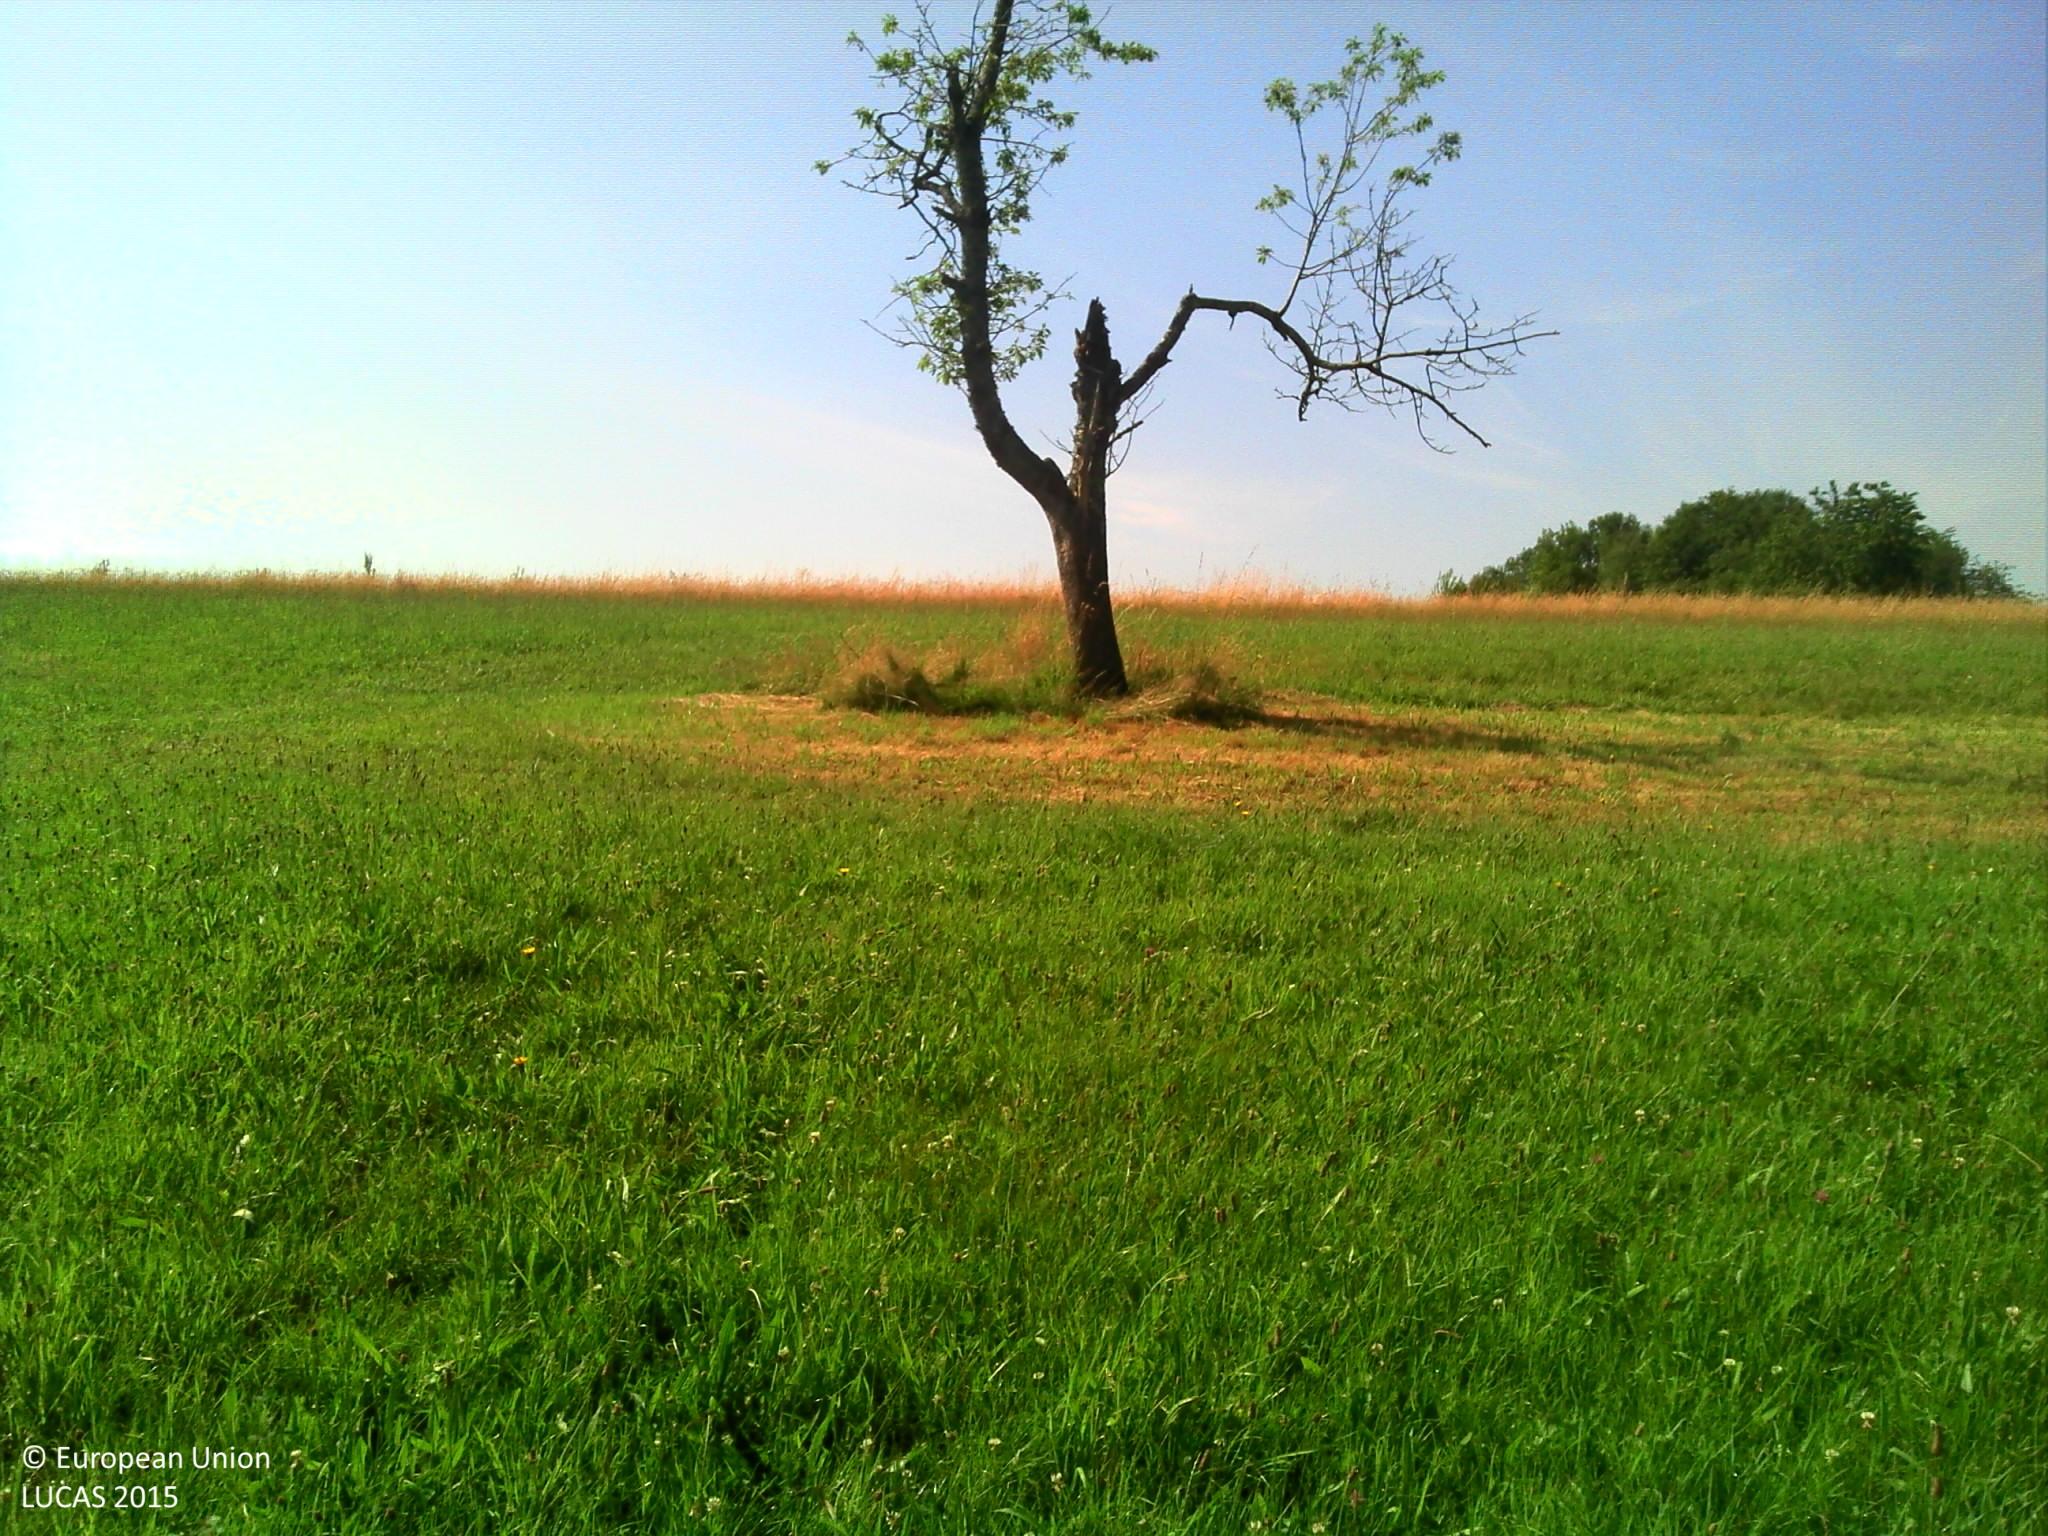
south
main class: Grassland
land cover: Grassland without tree/shrub cover
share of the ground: > 75 %
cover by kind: herbaceous plants 100 %
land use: Agriculture (excluding fallow land and kitchen gardens)
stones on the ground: < 10 %
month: June
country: FR
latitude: 47.6310
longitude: 6.6079
